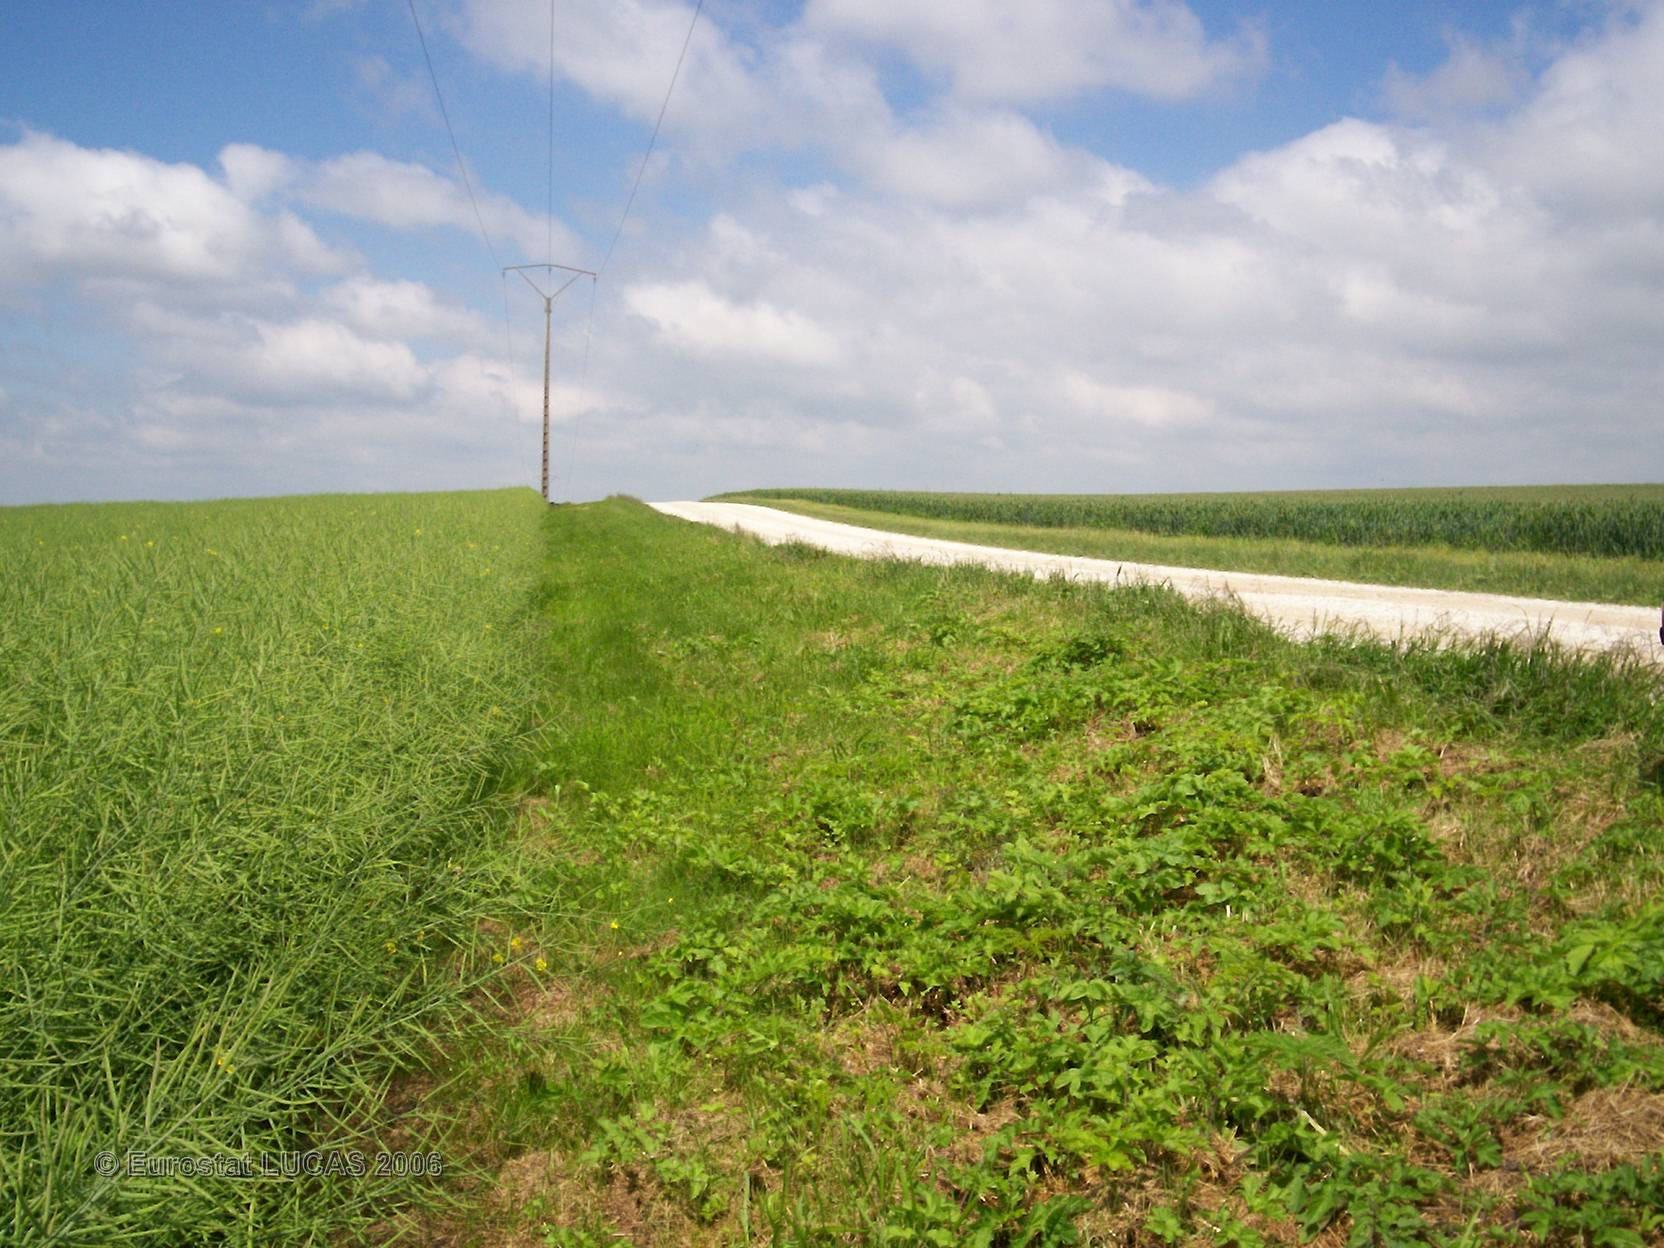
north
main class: Cropland
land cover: Rape and turnip rape
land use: Agriculture (excluding fallow land and kitchen gardens)
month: June
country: FR
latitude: 48.6234
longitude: 4.4210
